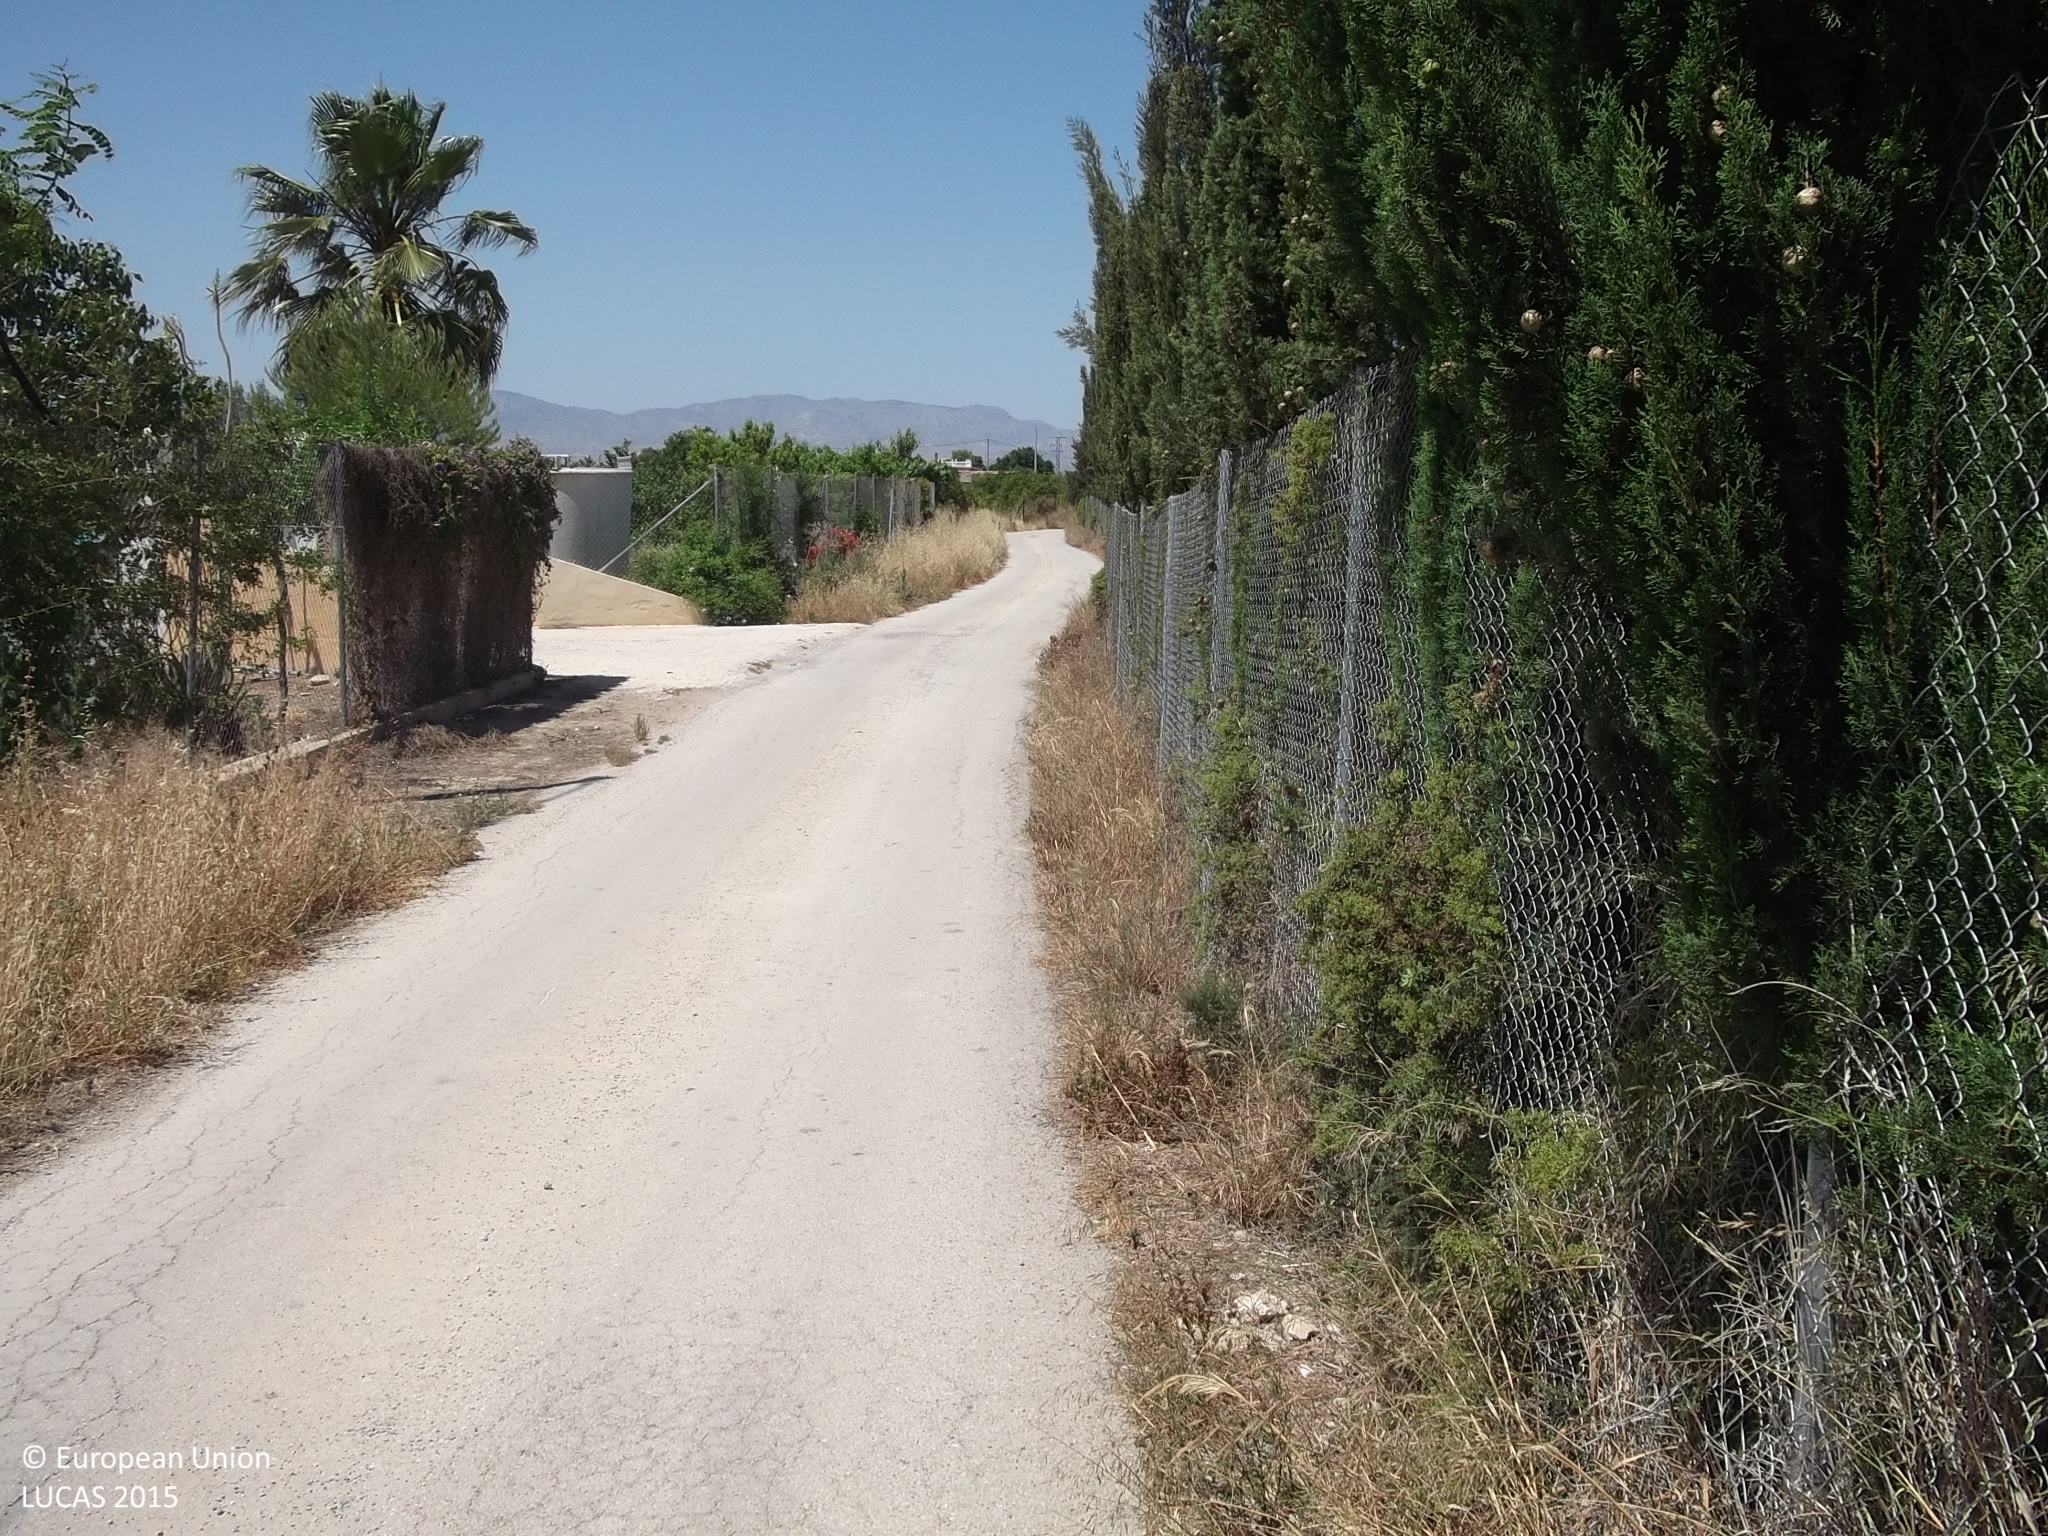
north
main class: Cropland
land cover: Oranges
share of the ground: < 10 %
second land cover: Spontaneously vegetated surfaces
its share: 25 - 50 %
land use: Agriculture (excluding fallow land and kitchen gardens)
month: May
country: ES
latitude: 38.0962
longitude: -0.8280
